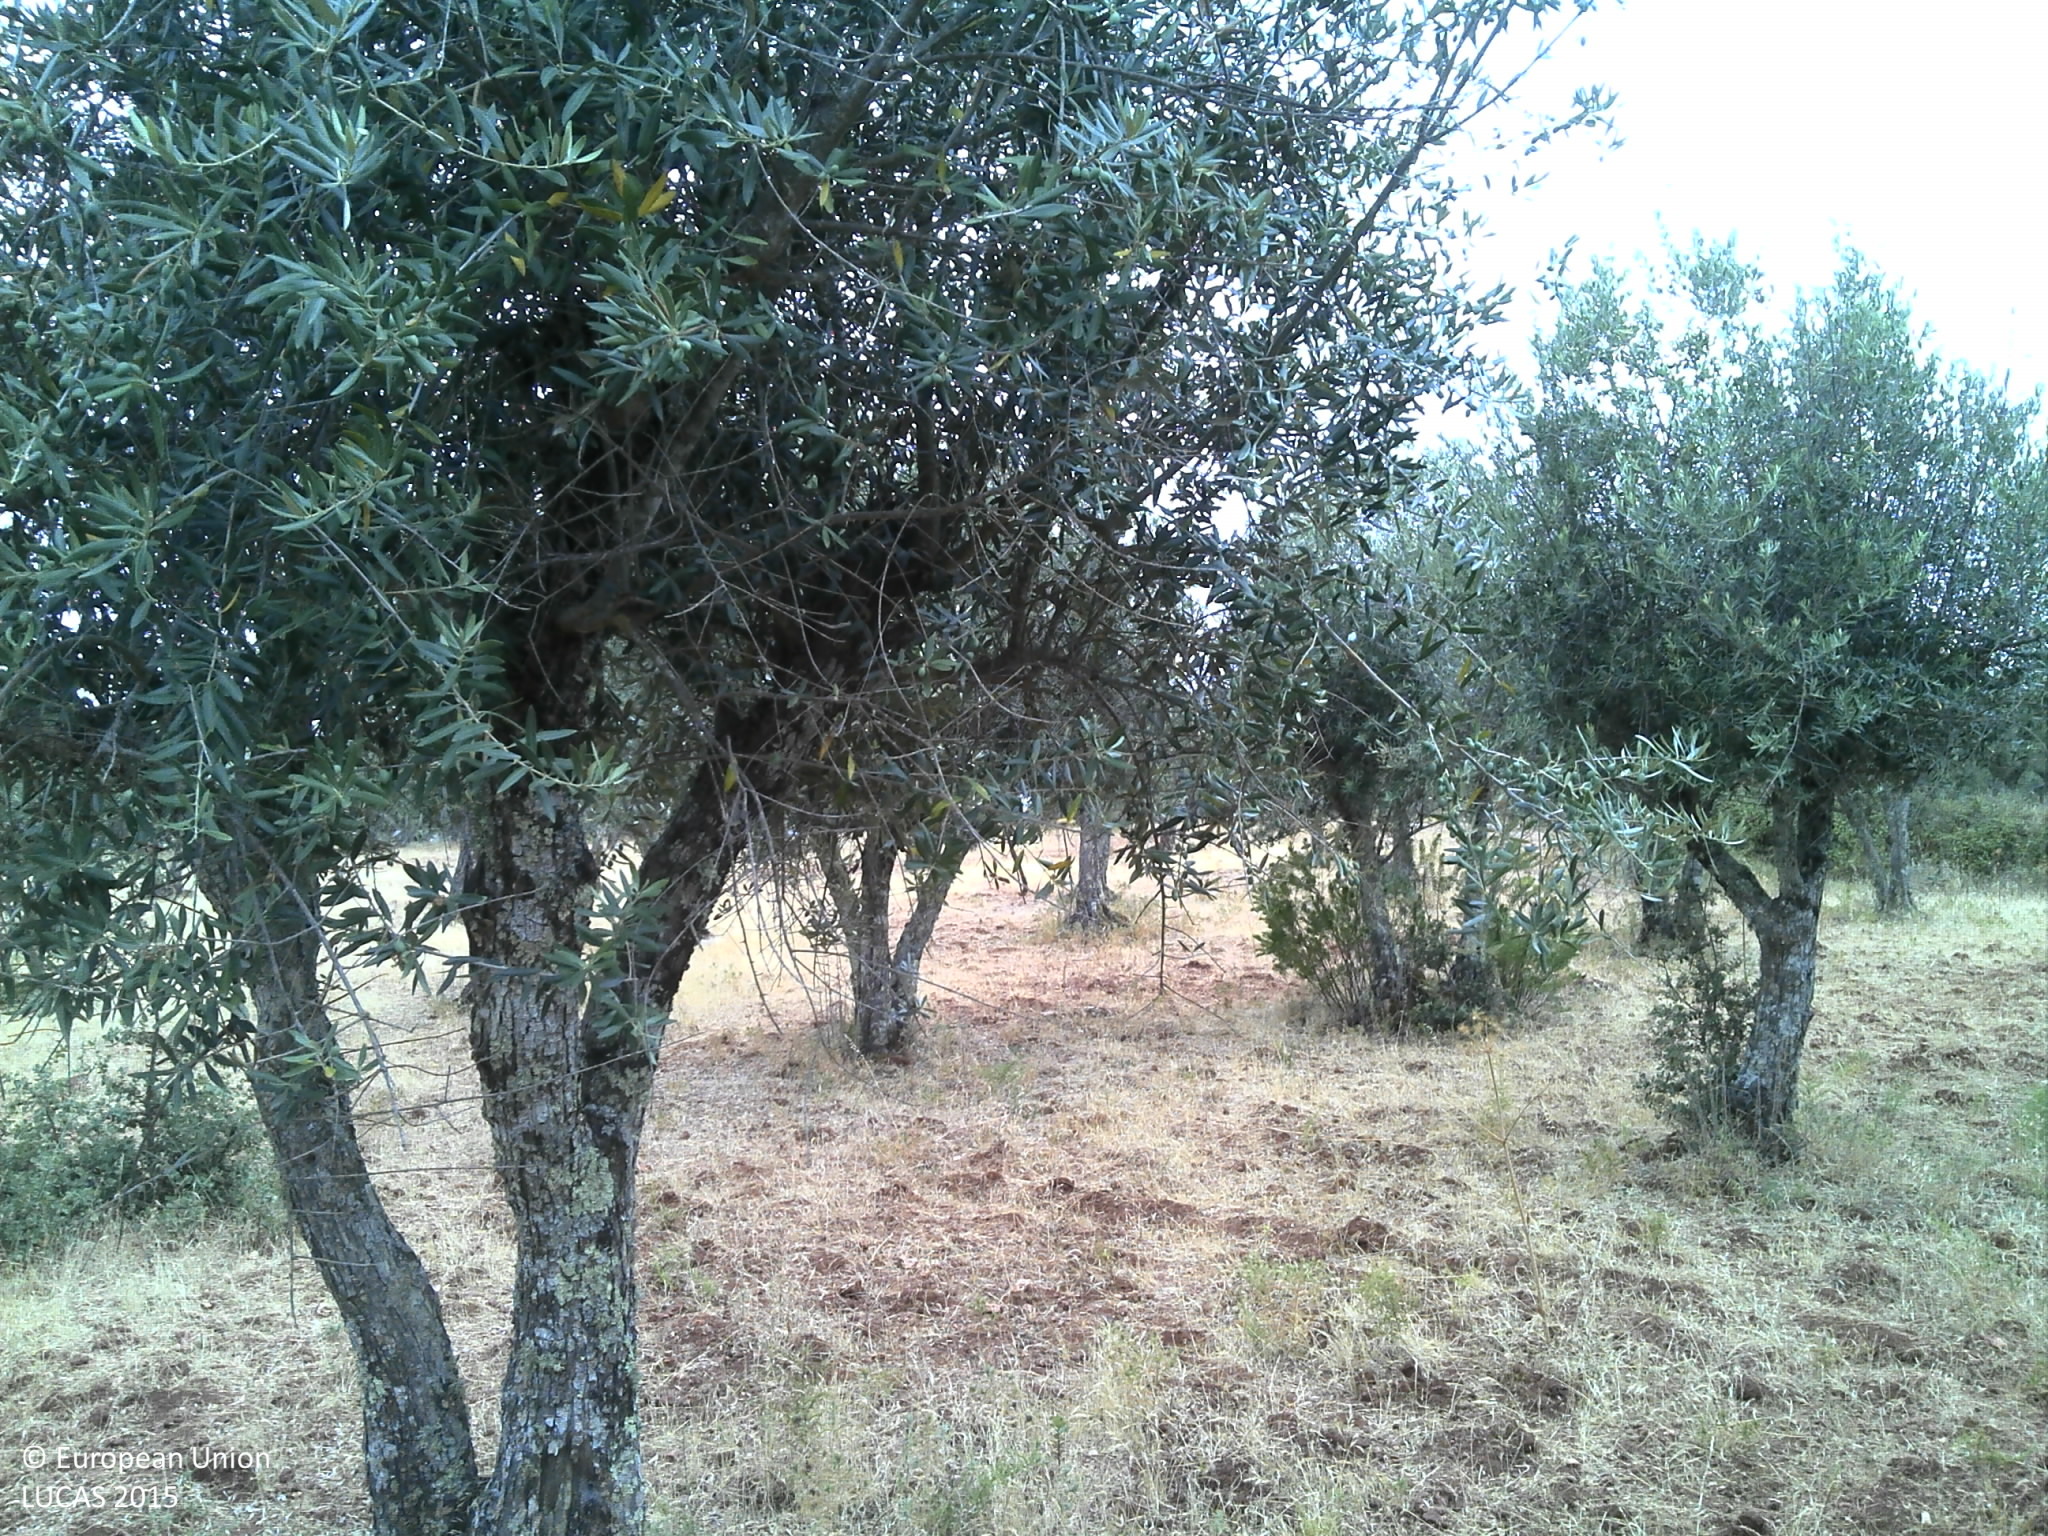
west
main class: Cropland
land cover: Olive groves
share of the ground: 25 - 50 %
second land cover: Grassland without tree/shrub cover
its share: 25 - 50 %
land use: Agriculture (excluding fallow land and kitchen gardens)
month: July
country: PT
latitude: 38.7915
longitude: -7.4991
